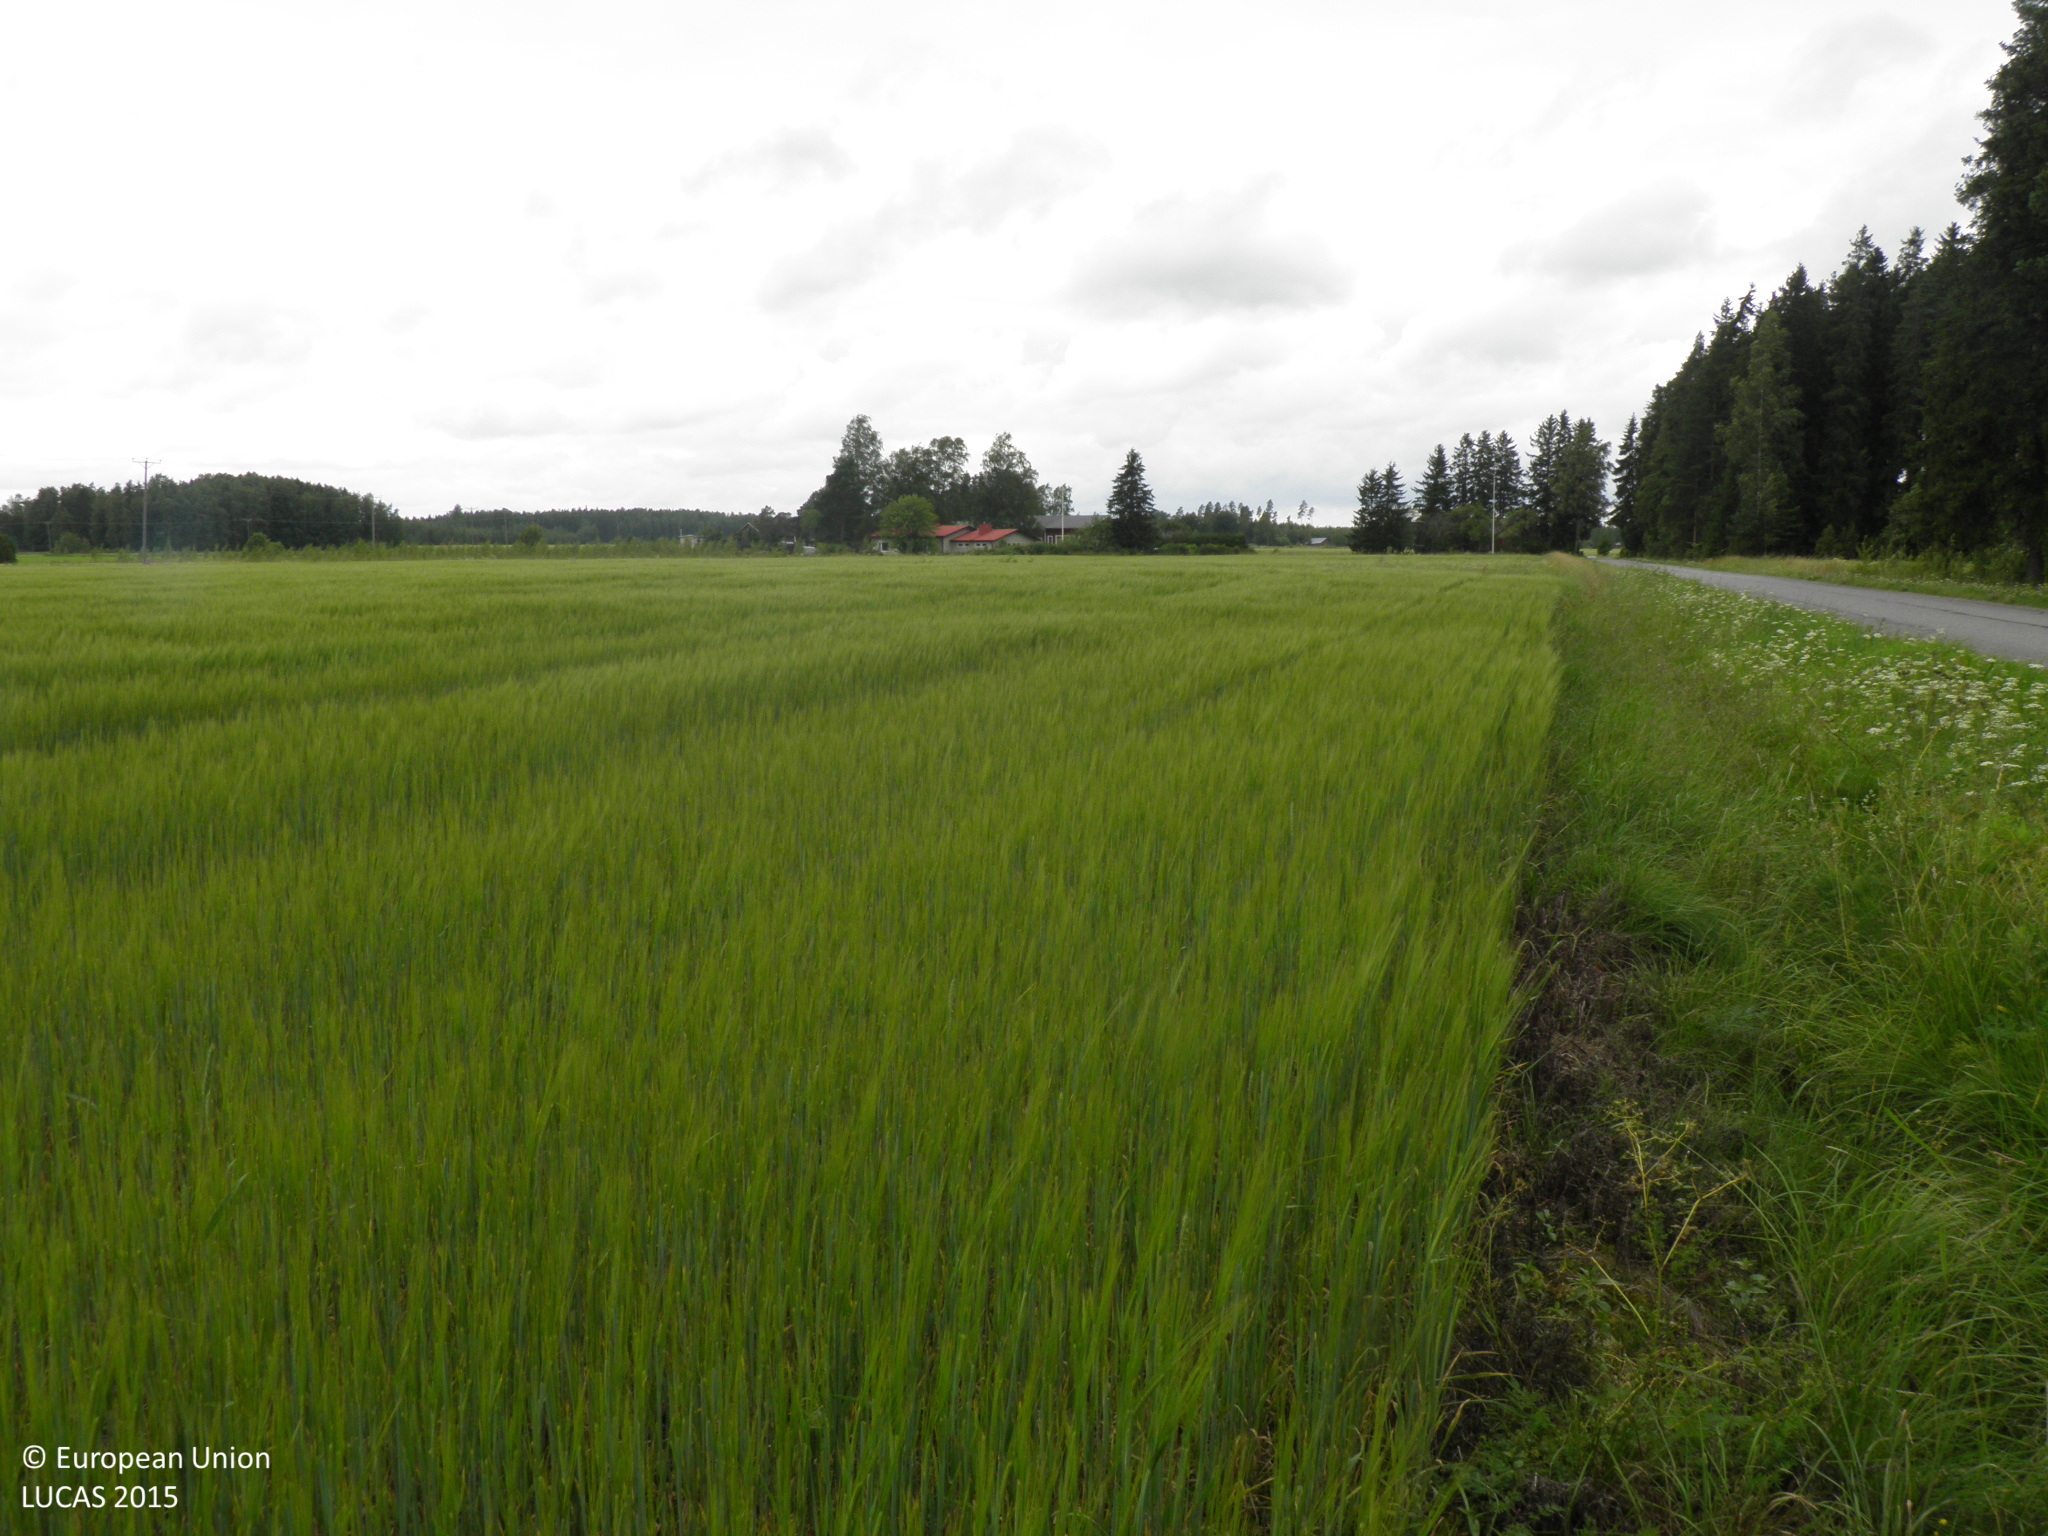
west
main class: Cropland
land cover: Barley
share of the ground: > 75 %
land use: Agriculture (excluding fallow land and kitchen gardens)
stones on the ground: < 10 %
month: July
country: FI
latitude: 60.8786
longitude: 22.9507
